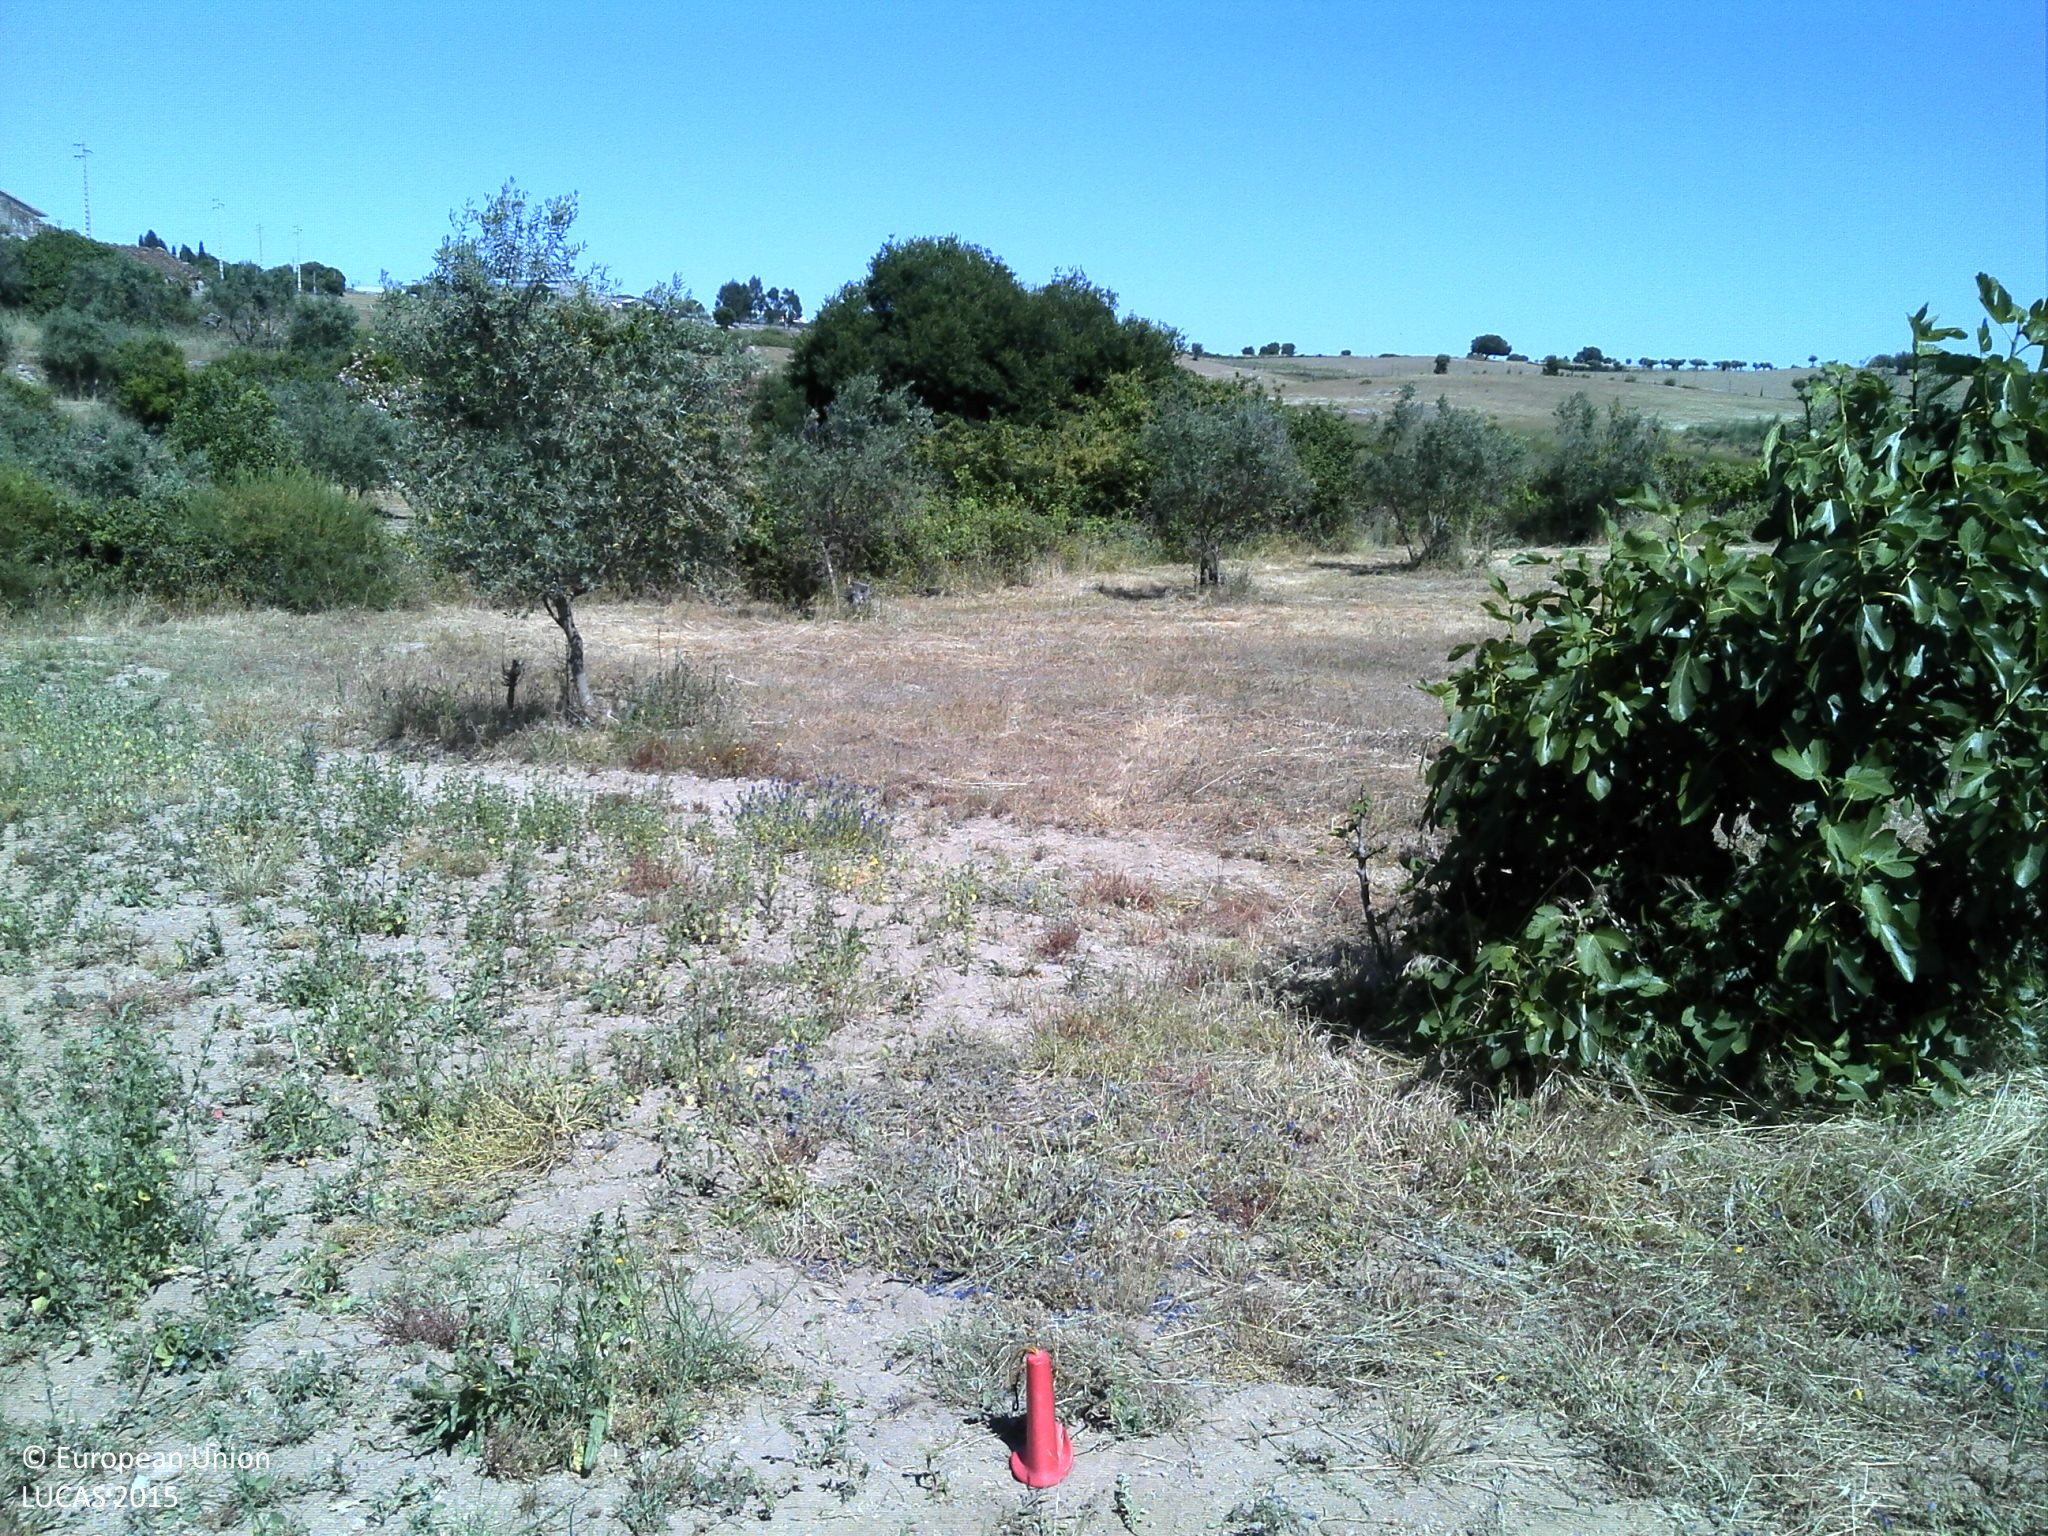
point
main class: Cropland
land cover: Olive groves
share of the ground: 25 - 50 %
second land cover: Grassland without tree/shrub cover
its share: 25 - 50 %
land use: Agriculture (excluding fallow land and kitchen gardens)
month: May
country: PT
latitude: 39.4161
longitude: -7.7170
